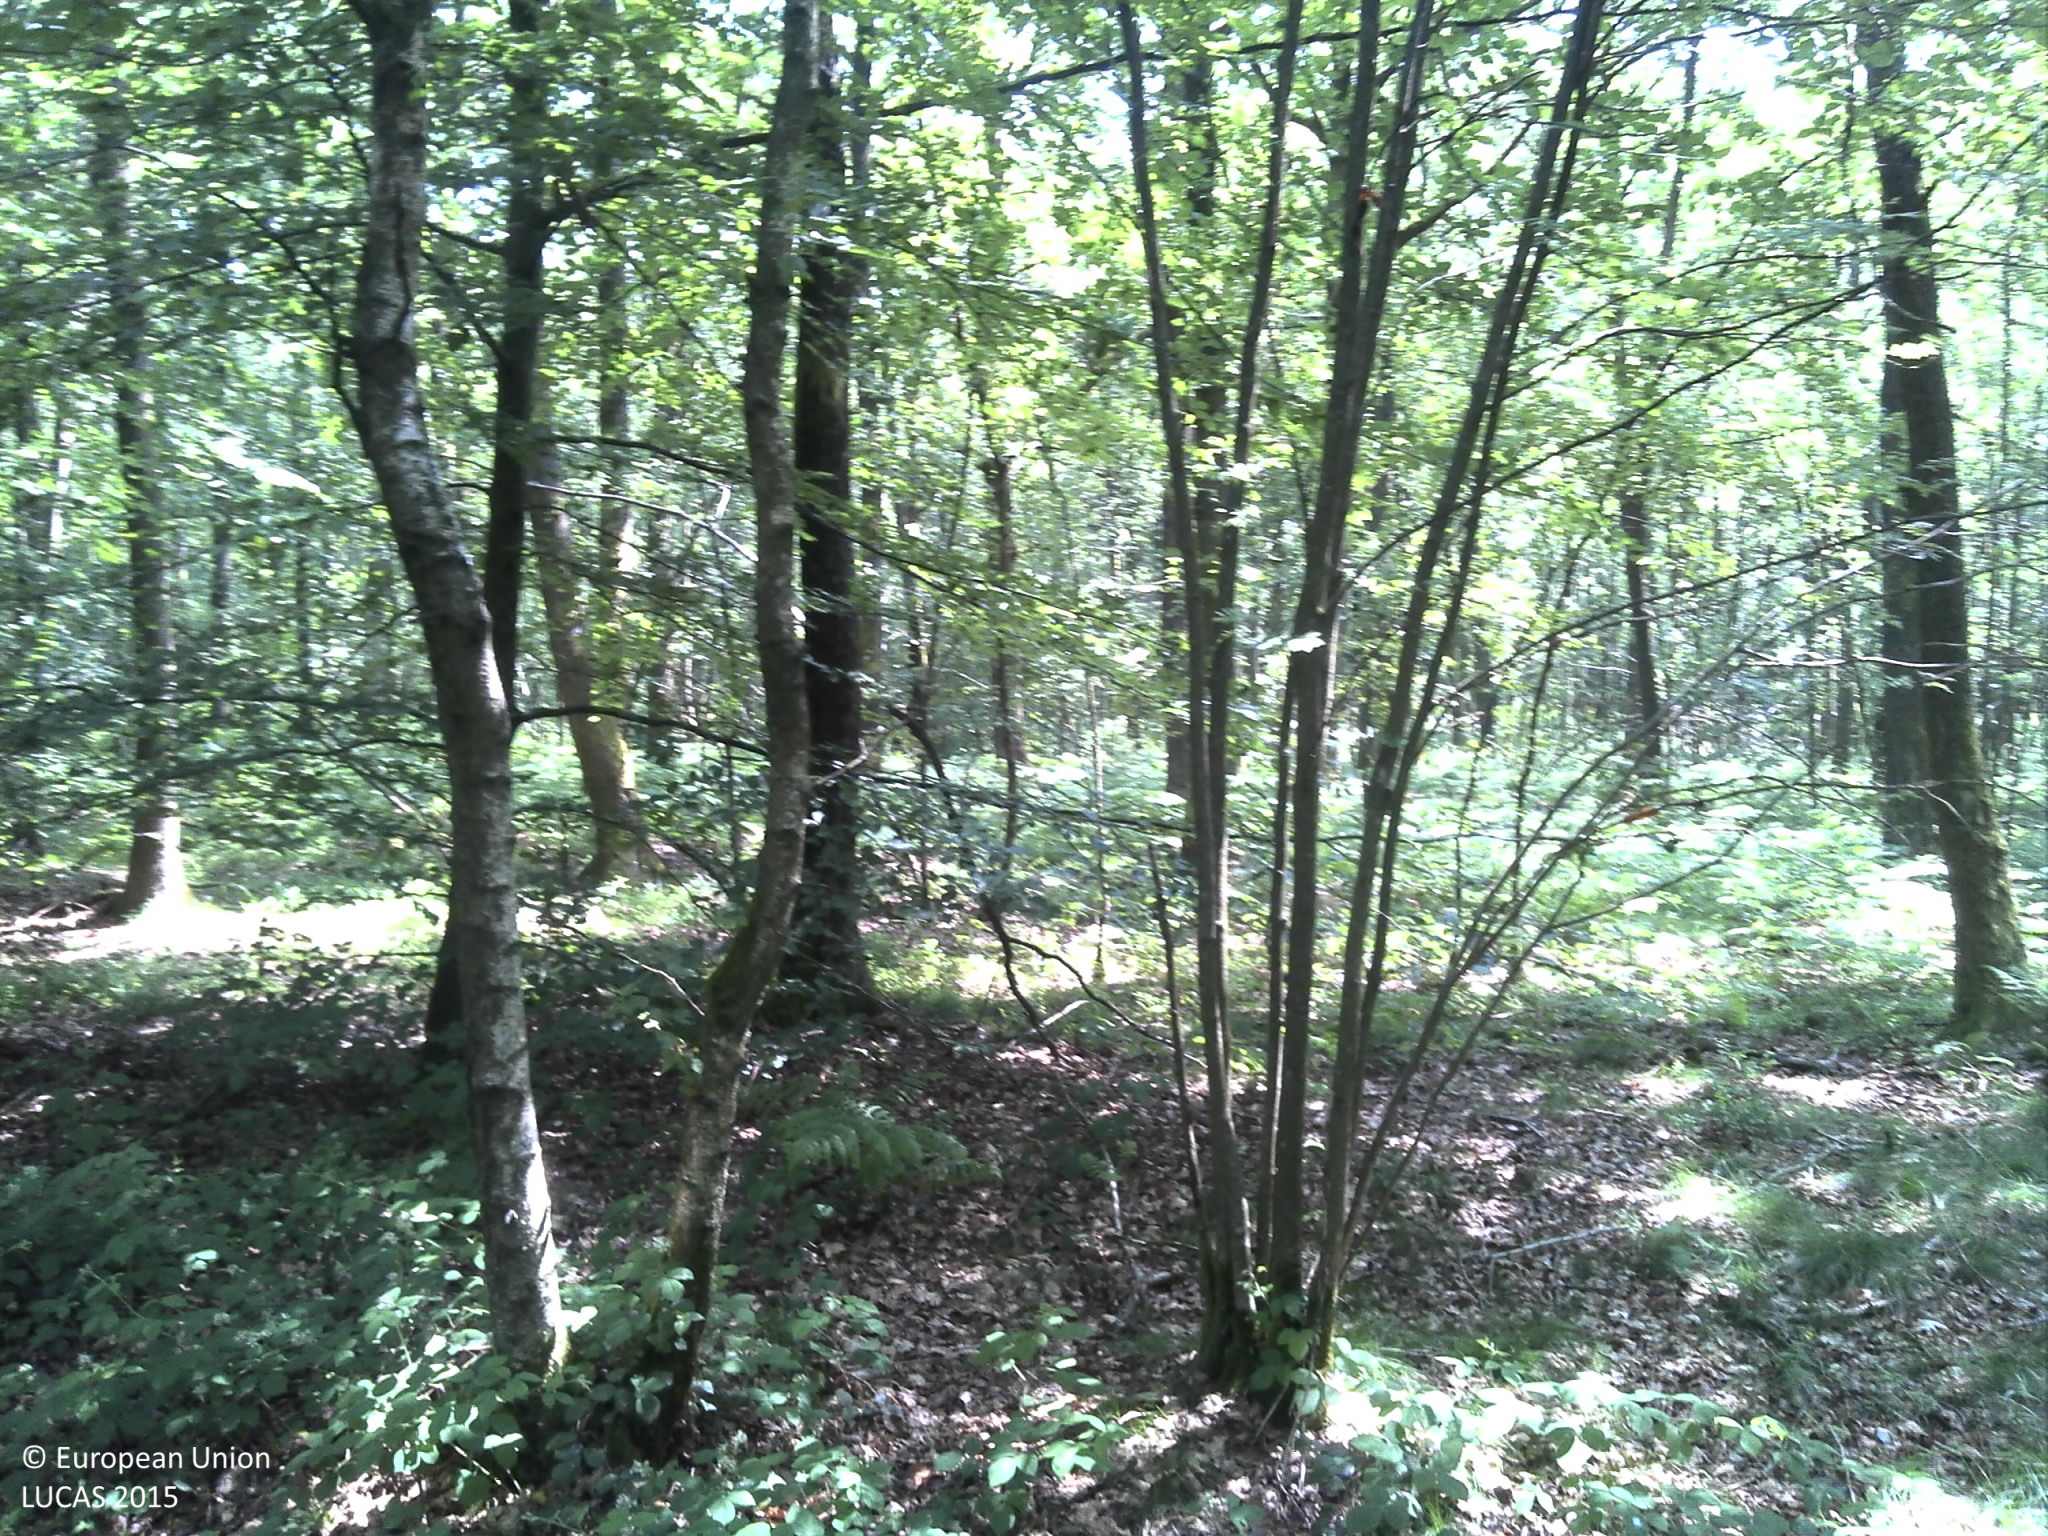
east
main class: Woodland
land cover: Broadleaved woodland
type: acidophilous oak and oak-birch forest
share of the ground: 50 - 75 %
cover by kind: broadleaved forest trees 70 %, herbaceous plants 25 %, consolidated bare surface 5 %
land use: Forestry
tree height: > 5 m
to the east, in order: Broadleaved woodland
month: July
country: FR
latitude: 49.9203
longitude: 4.7738
